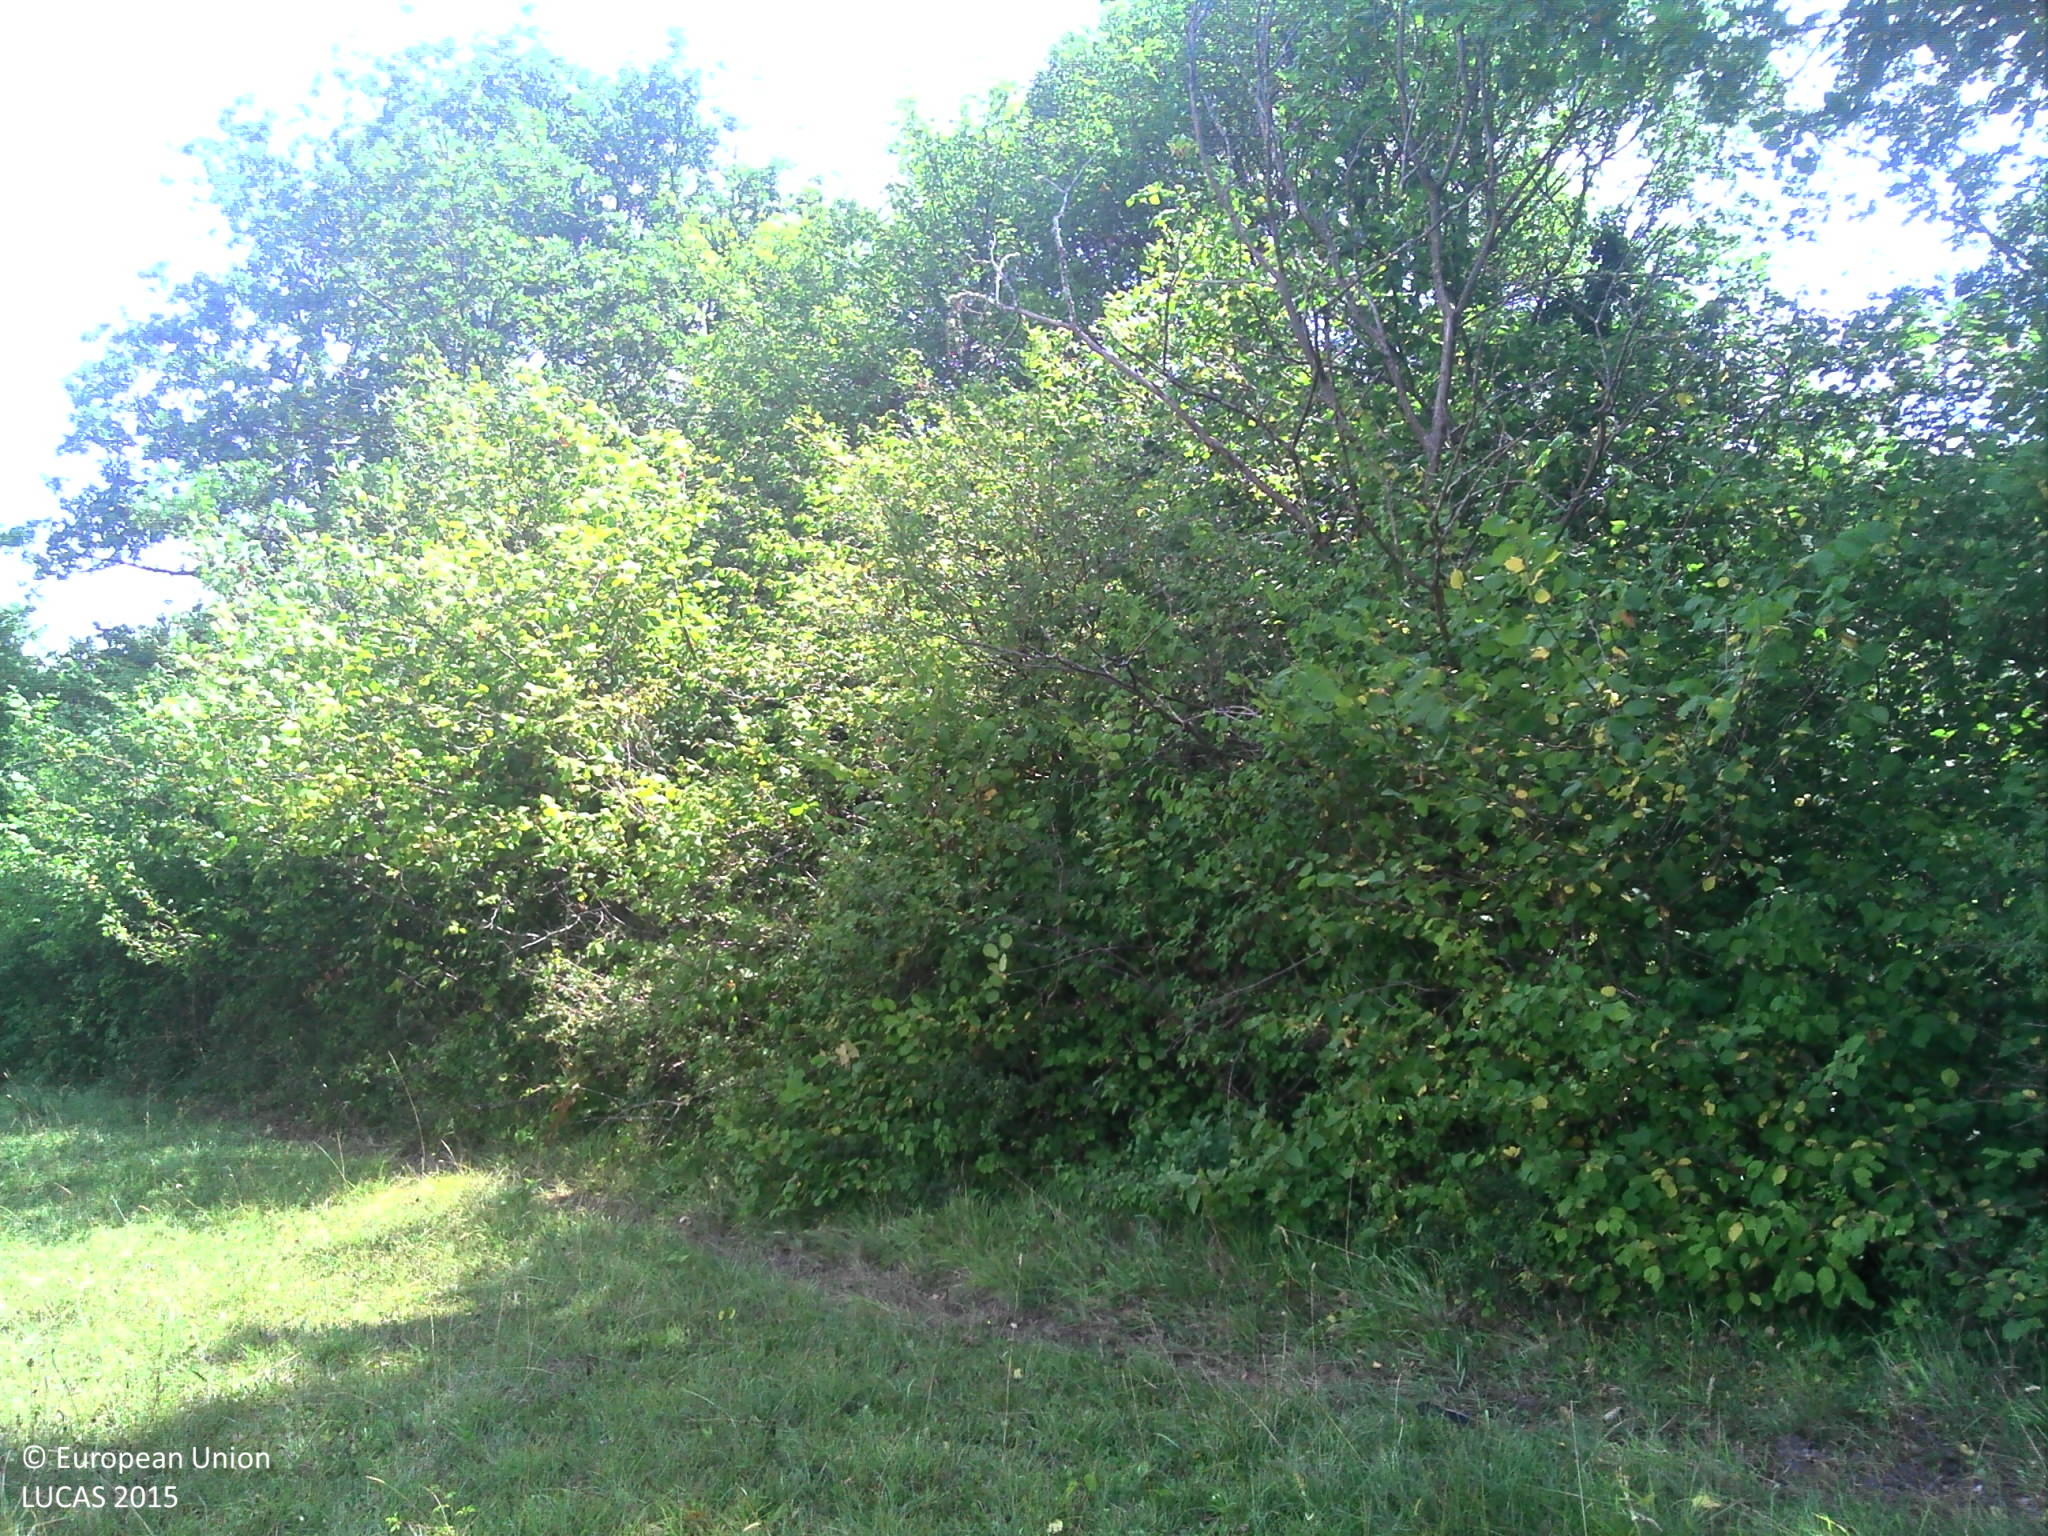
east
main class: Grassland
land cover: Grassland without tree/shrub cover
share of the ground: > 75 %
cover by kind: herbaceous plants 100 %
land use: Agriculture (excluding fallow land and kitchen gardens)
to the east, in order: Grassland without tree/shrub cover; Fences; Broadleaved woodland; Grassland without tree/shrub cover; Fences; Grassland without tree/shrub cover; Fences; Broadleaved woodland; Ditches and canals; Broadleaved woodland; Fences; Grassland without tree/shrub cover; Abandoned hedges; Grassland without tree/shrub cover
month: July
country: FR
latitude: 43.1664
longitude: 0.8634
